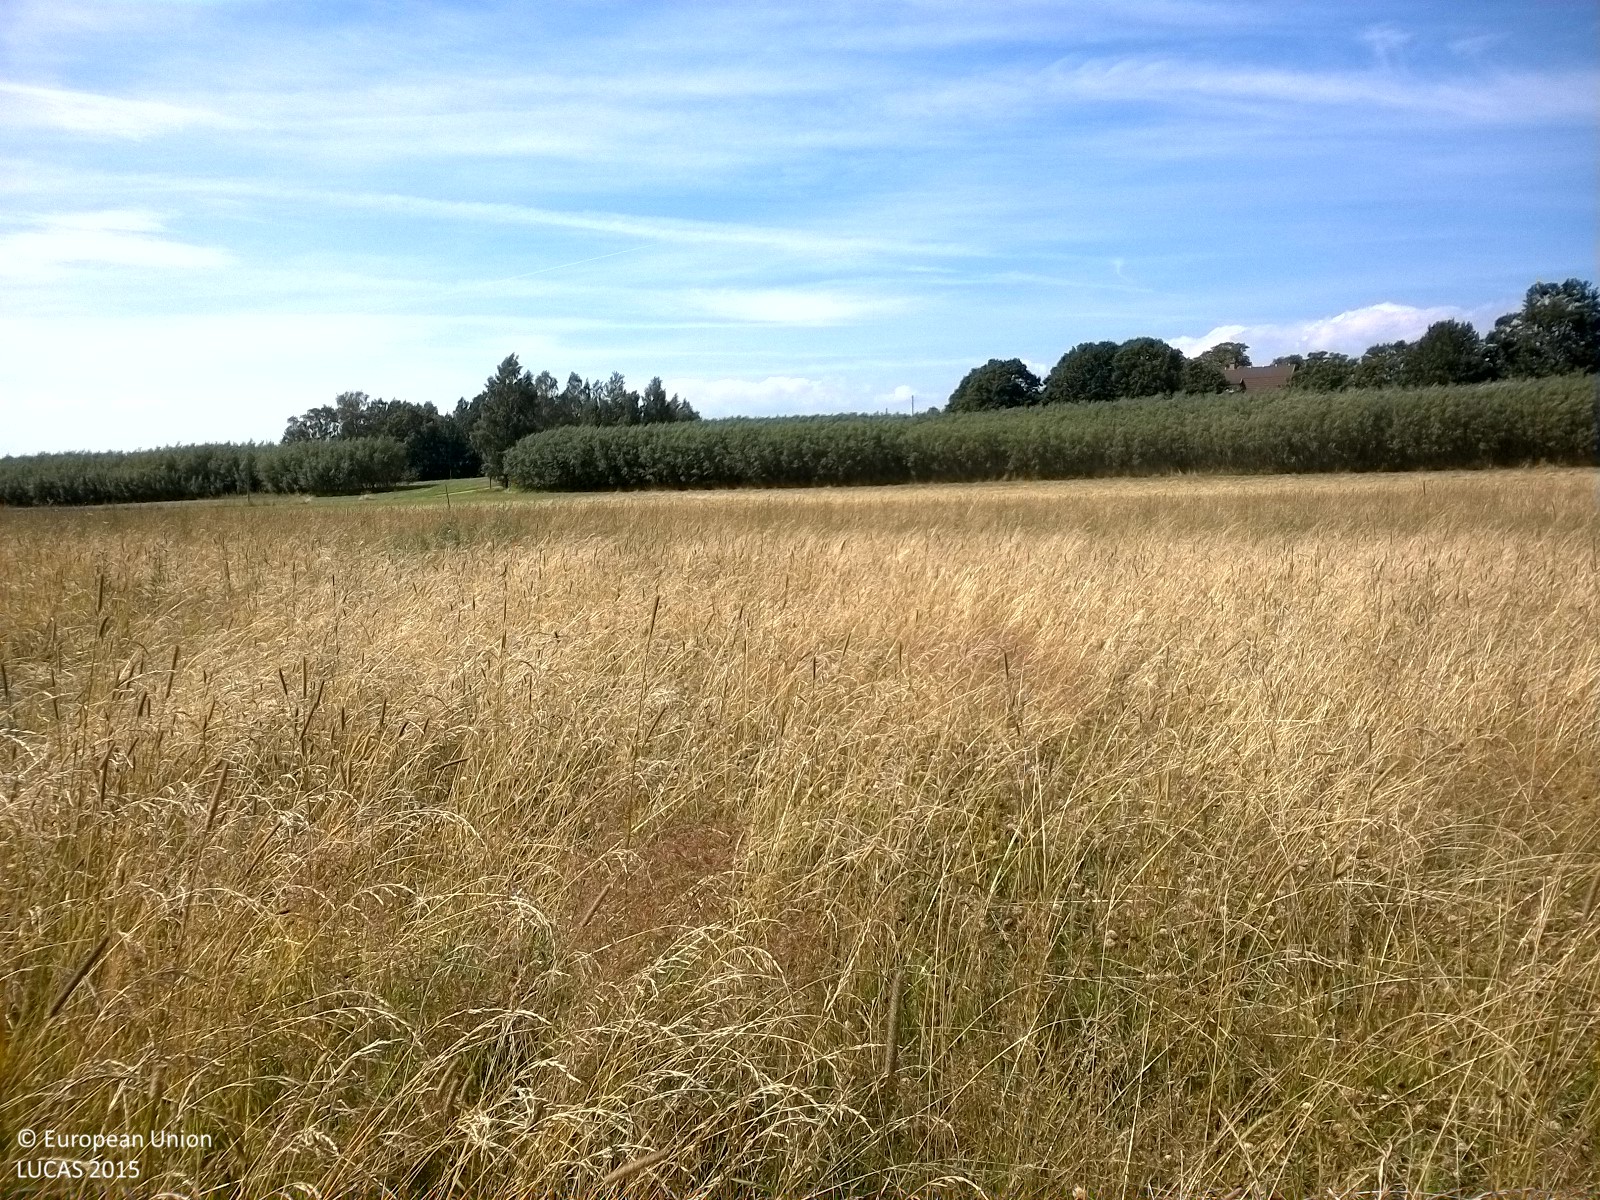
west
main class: Grassland
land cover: Grassland without tree/shrub cover
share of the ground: > 75 %
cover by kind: herbaceous plants 100 %
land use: Agriculture (excluding fallow land and kitchen gardens)
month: August
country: SE
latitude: 58.7221
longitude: 14.9837
